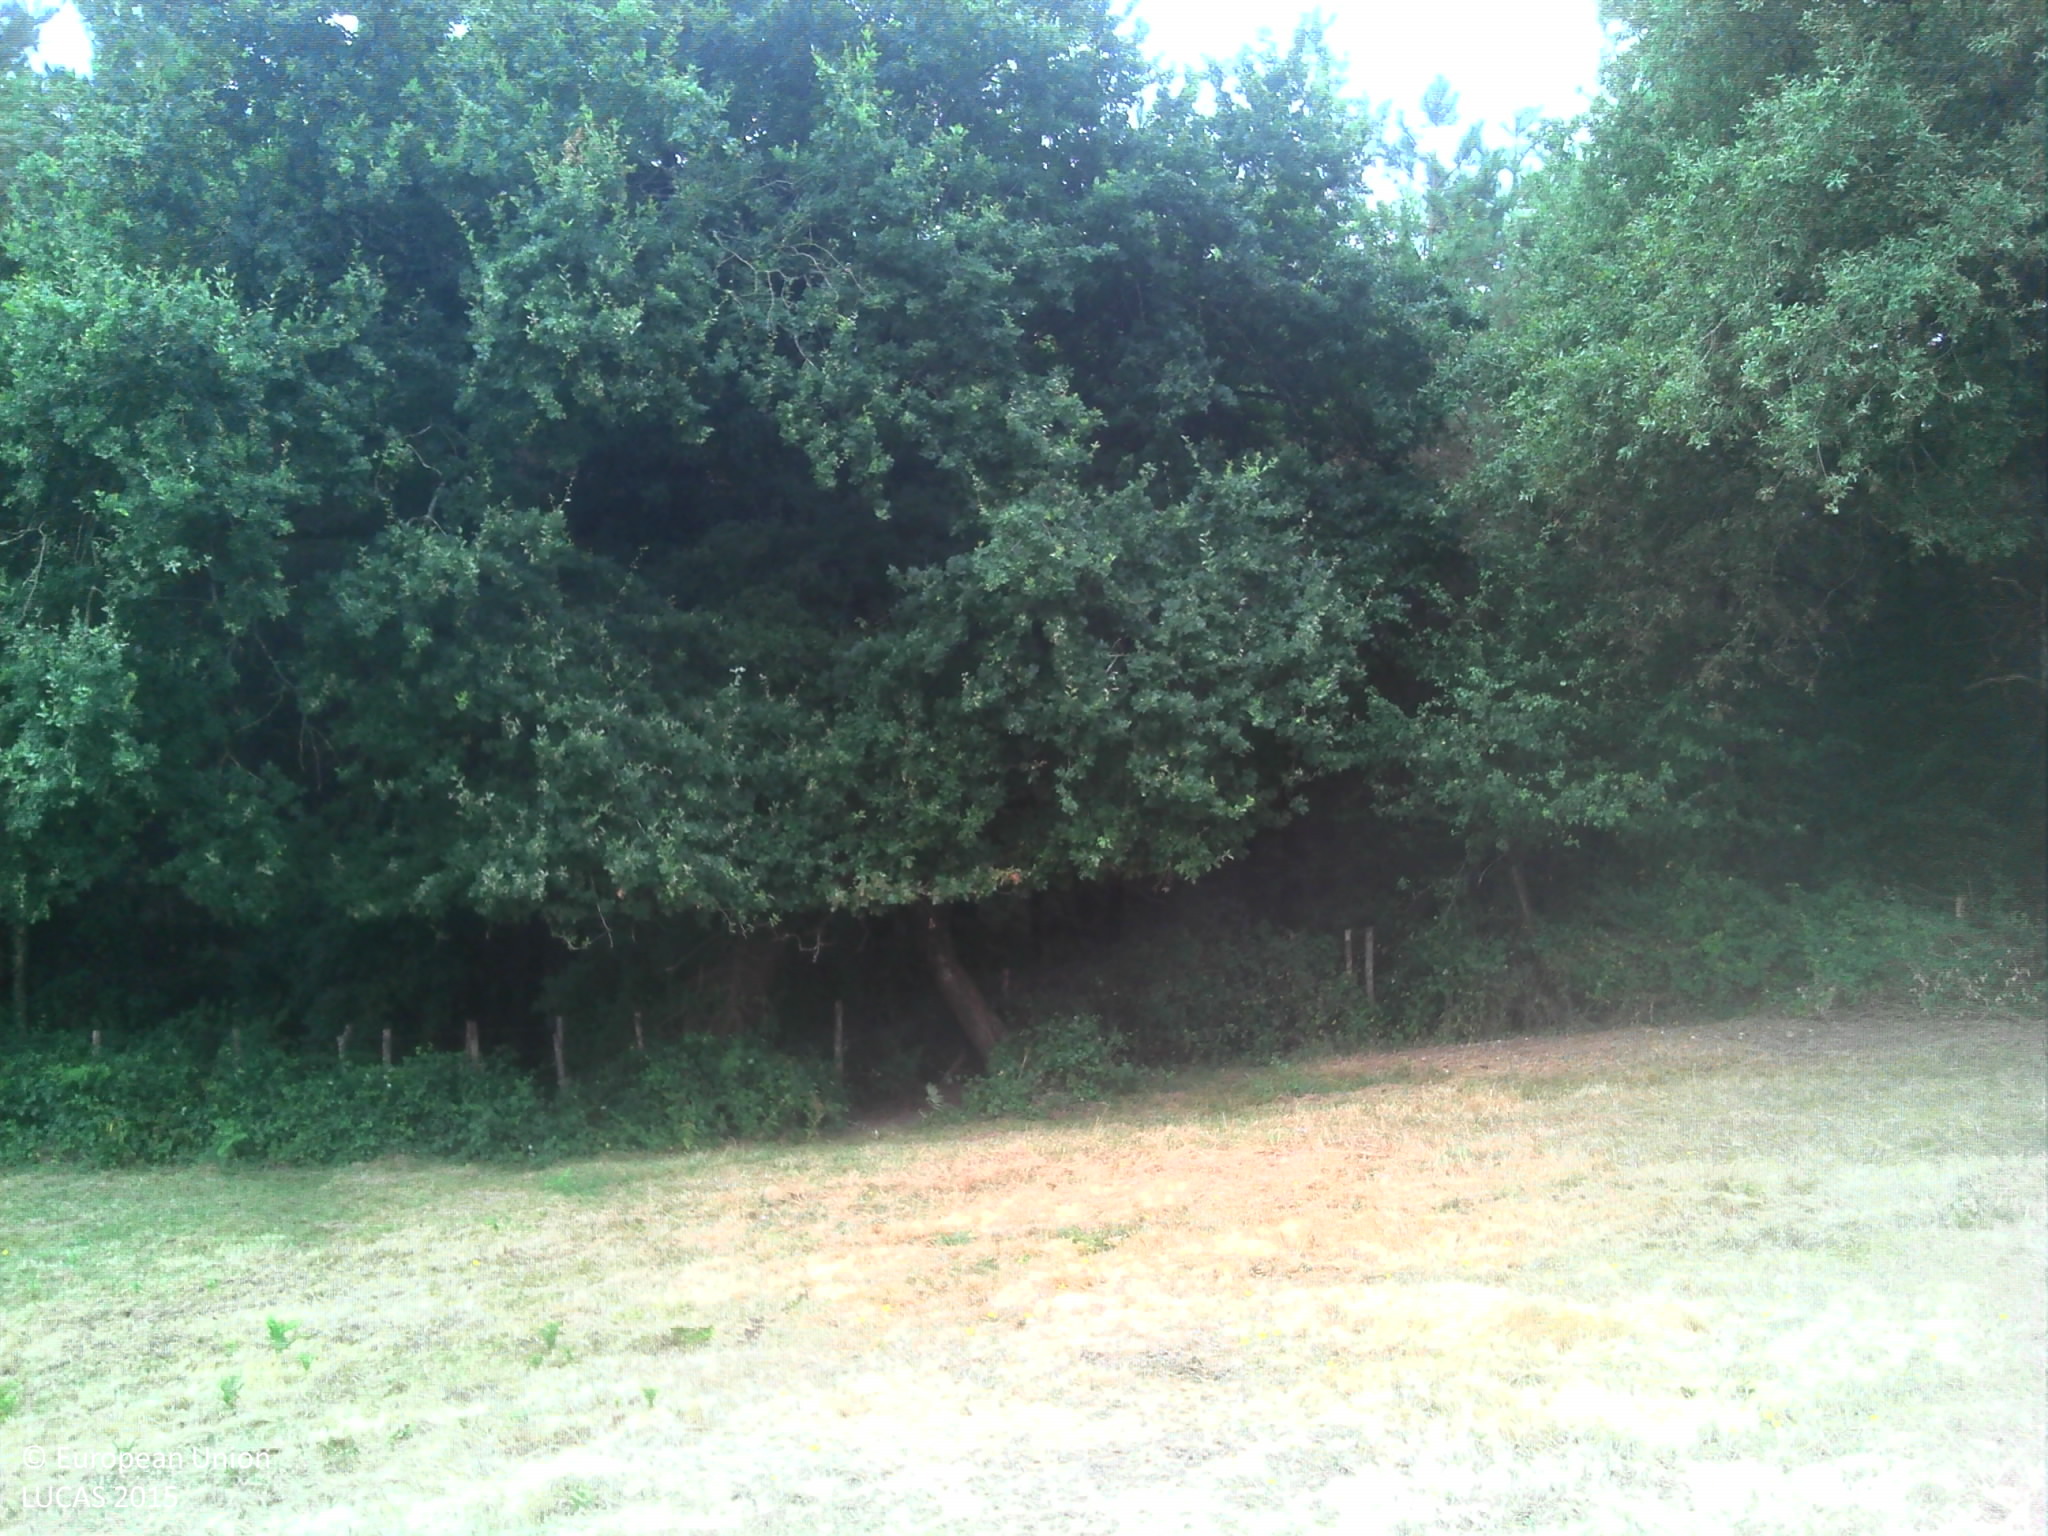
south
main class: Grassland
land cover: Grassland without tree/shrub cover
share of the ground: > 75 %
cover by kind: herbaceous plants 100 %
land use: Agriculture (excluding fallow land and kitchen gardens)
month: July
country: FR
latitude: 46.5224
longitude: -1.3906
